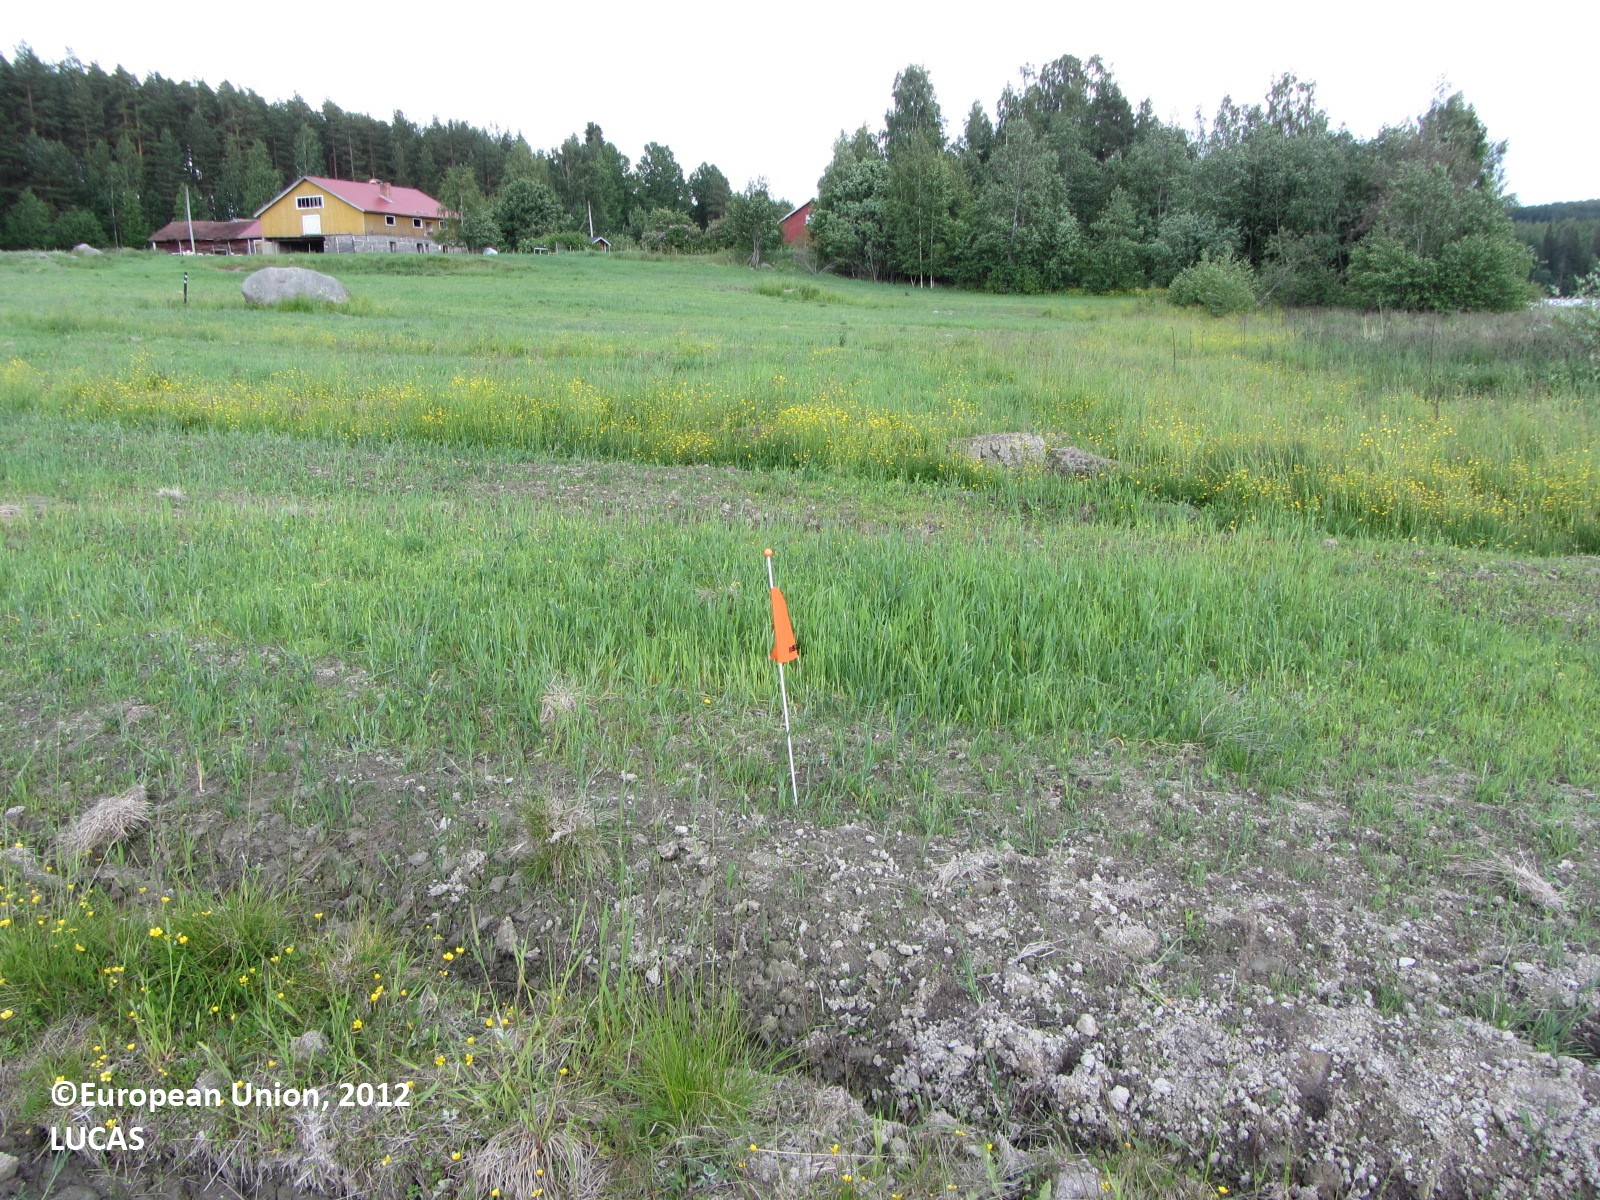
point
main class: Grassland
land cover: Grassland without tree/shrub cover
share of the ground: > 75 %
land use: Agriculture (excluding fallow land and kitchen gardens)
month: June
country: FI
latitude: 62.7595
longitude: 25.5214
